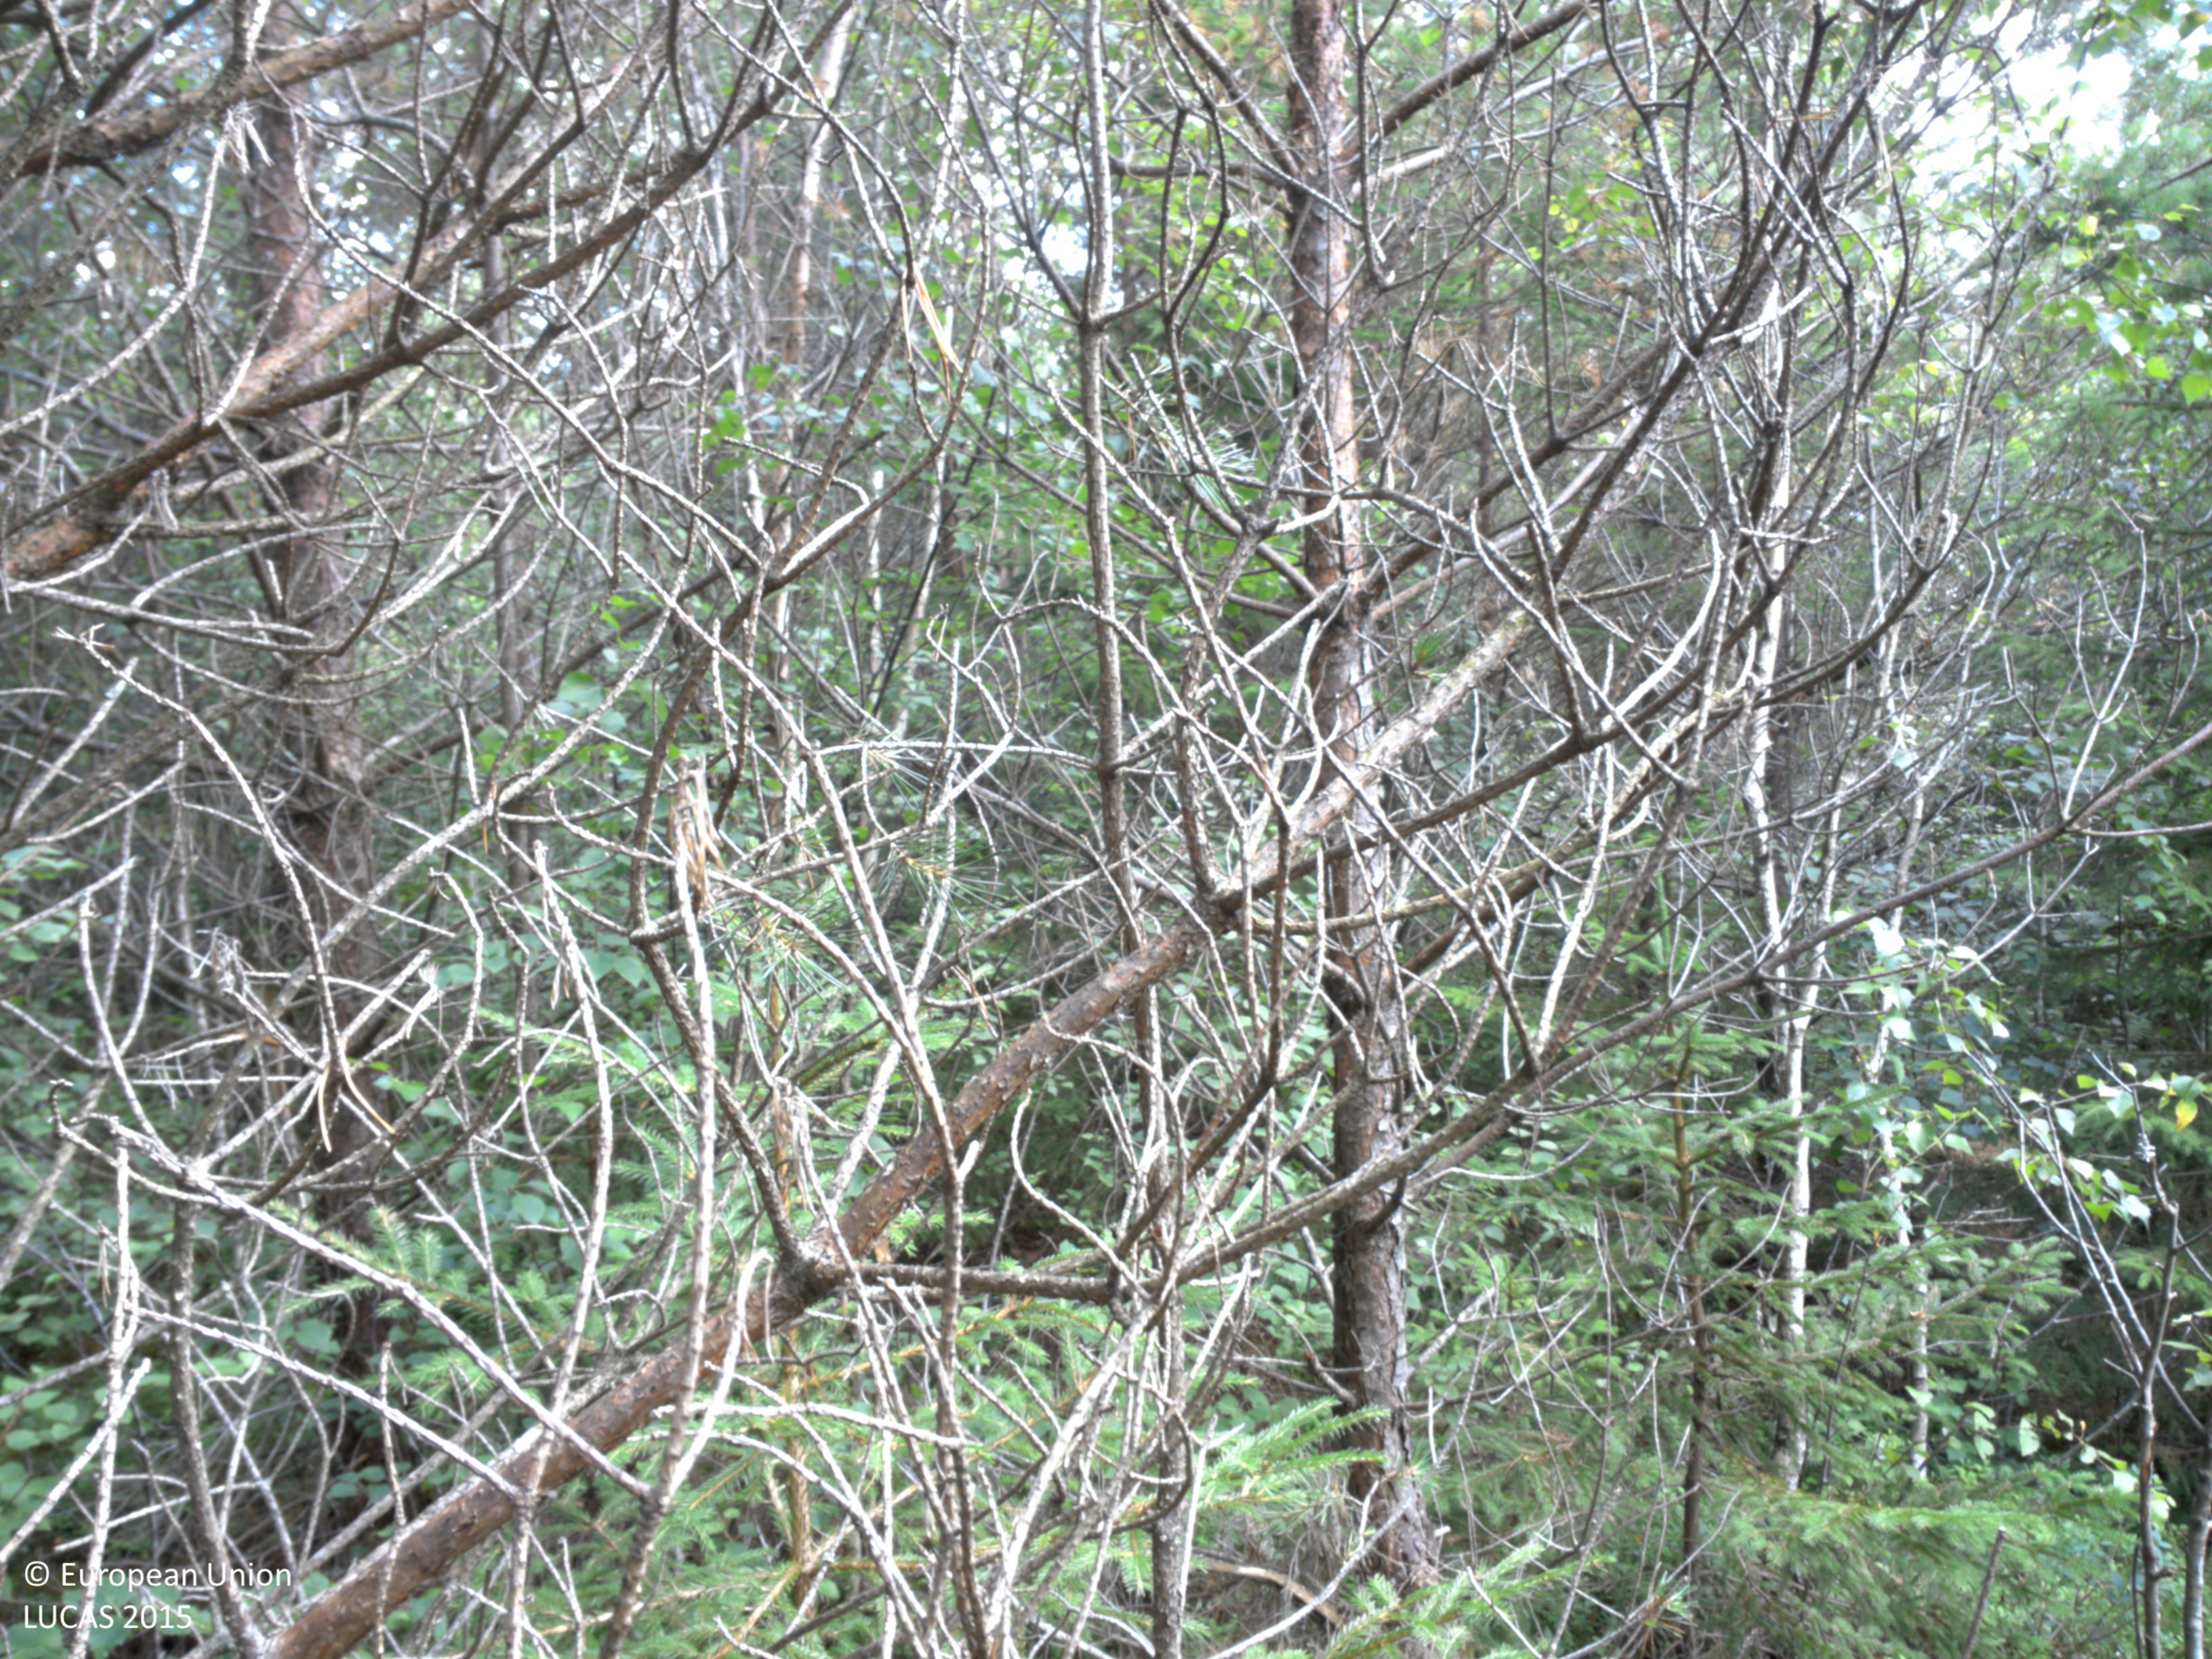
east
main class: Woodland
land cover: Spruce dominated mixed woodland
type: boreal forest
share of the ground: 50 - 75 %
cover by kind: coniferous forest trees 40 %, broadleaved forest trees 30 %, lichens and mosses 20 %, herbaceous plants 10 %
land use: Forestry
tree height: > 5 m
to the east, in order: Spruce dominated mixed woodland; Spruce dominated coniferous woodland; Spruce dominated mixed woodland; Dry stone walls; Fences; Temporary grasslands; Fences; Dry stone walls; Spruce dominated mixed woodland; Dry stone walls; Fences; Temporary grasslands
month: July
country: SE
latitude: 58.5865
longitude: 11.6993
